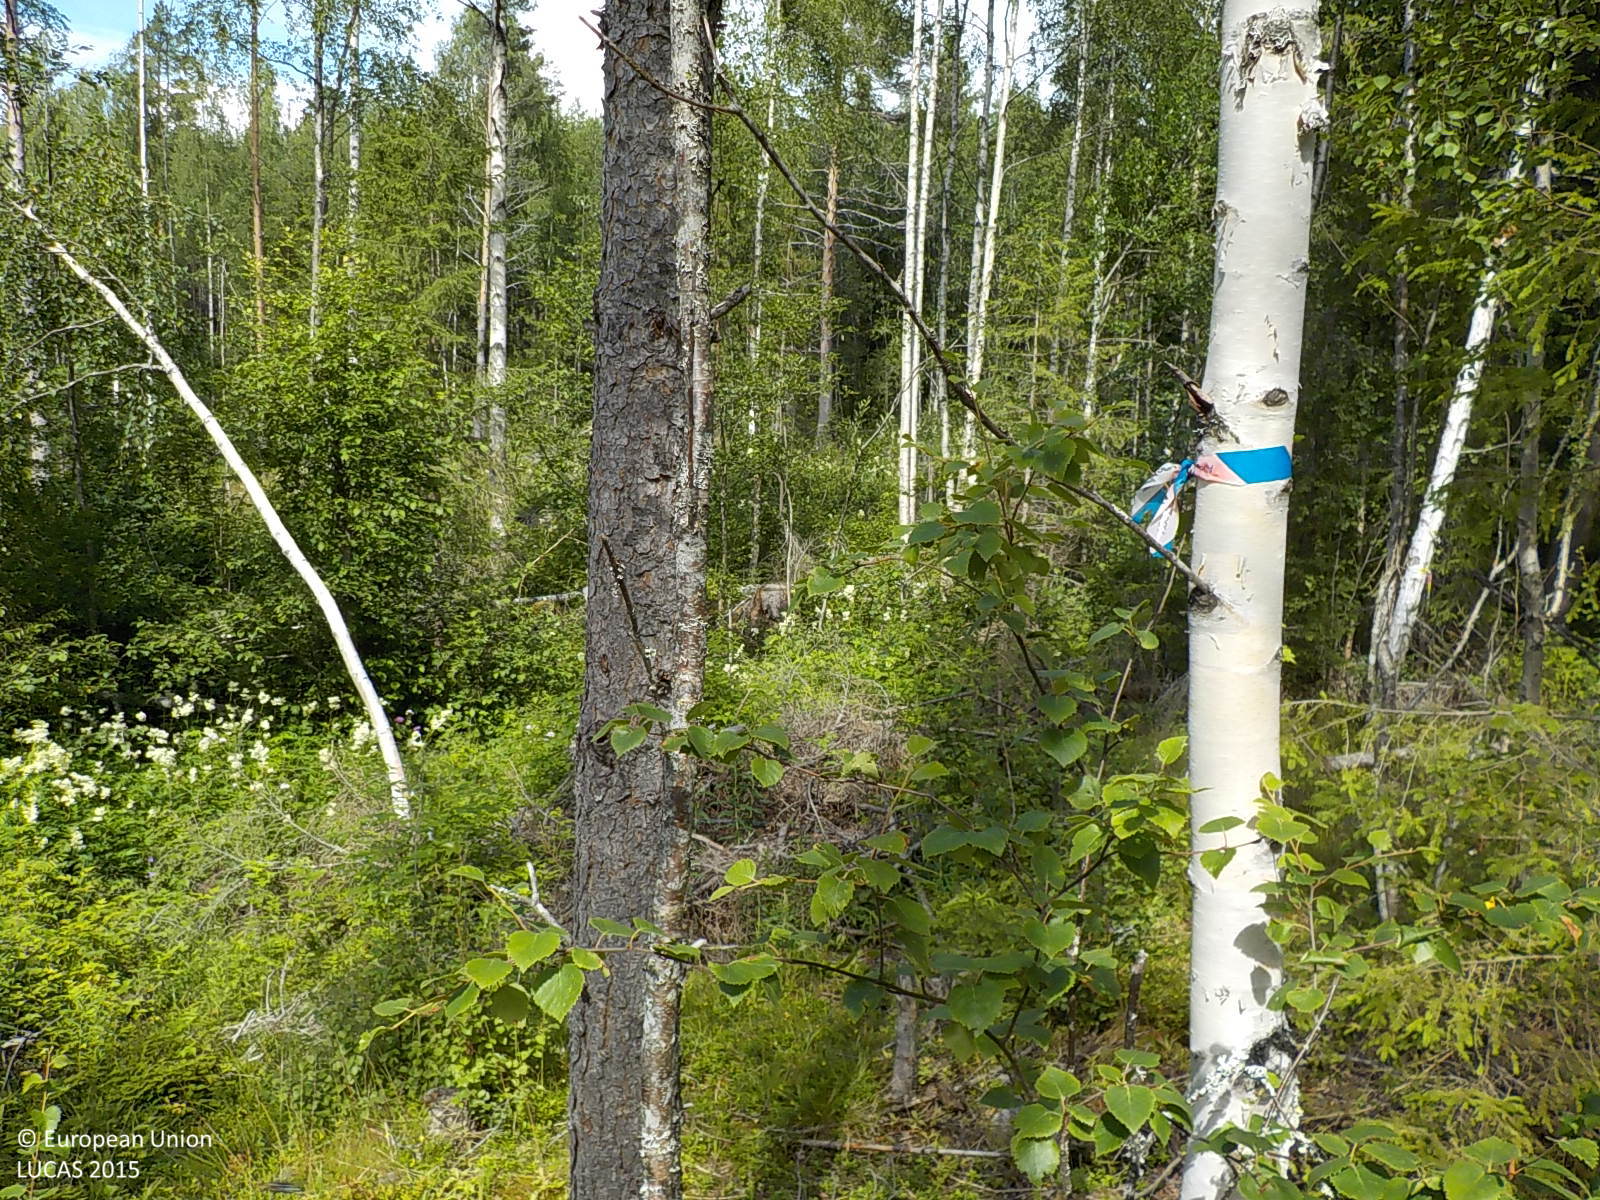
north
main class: Woodland
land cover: Pine dominated mixed woodland
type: boreal forest
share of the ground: > 75 %
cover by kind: coniferous forest trees 60 %, broadleaved forest trees 20 %, shrubs 20 %
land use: Forestry
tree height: > 5 m
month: July
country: SE
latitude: 63.2175
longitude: 17.2360
